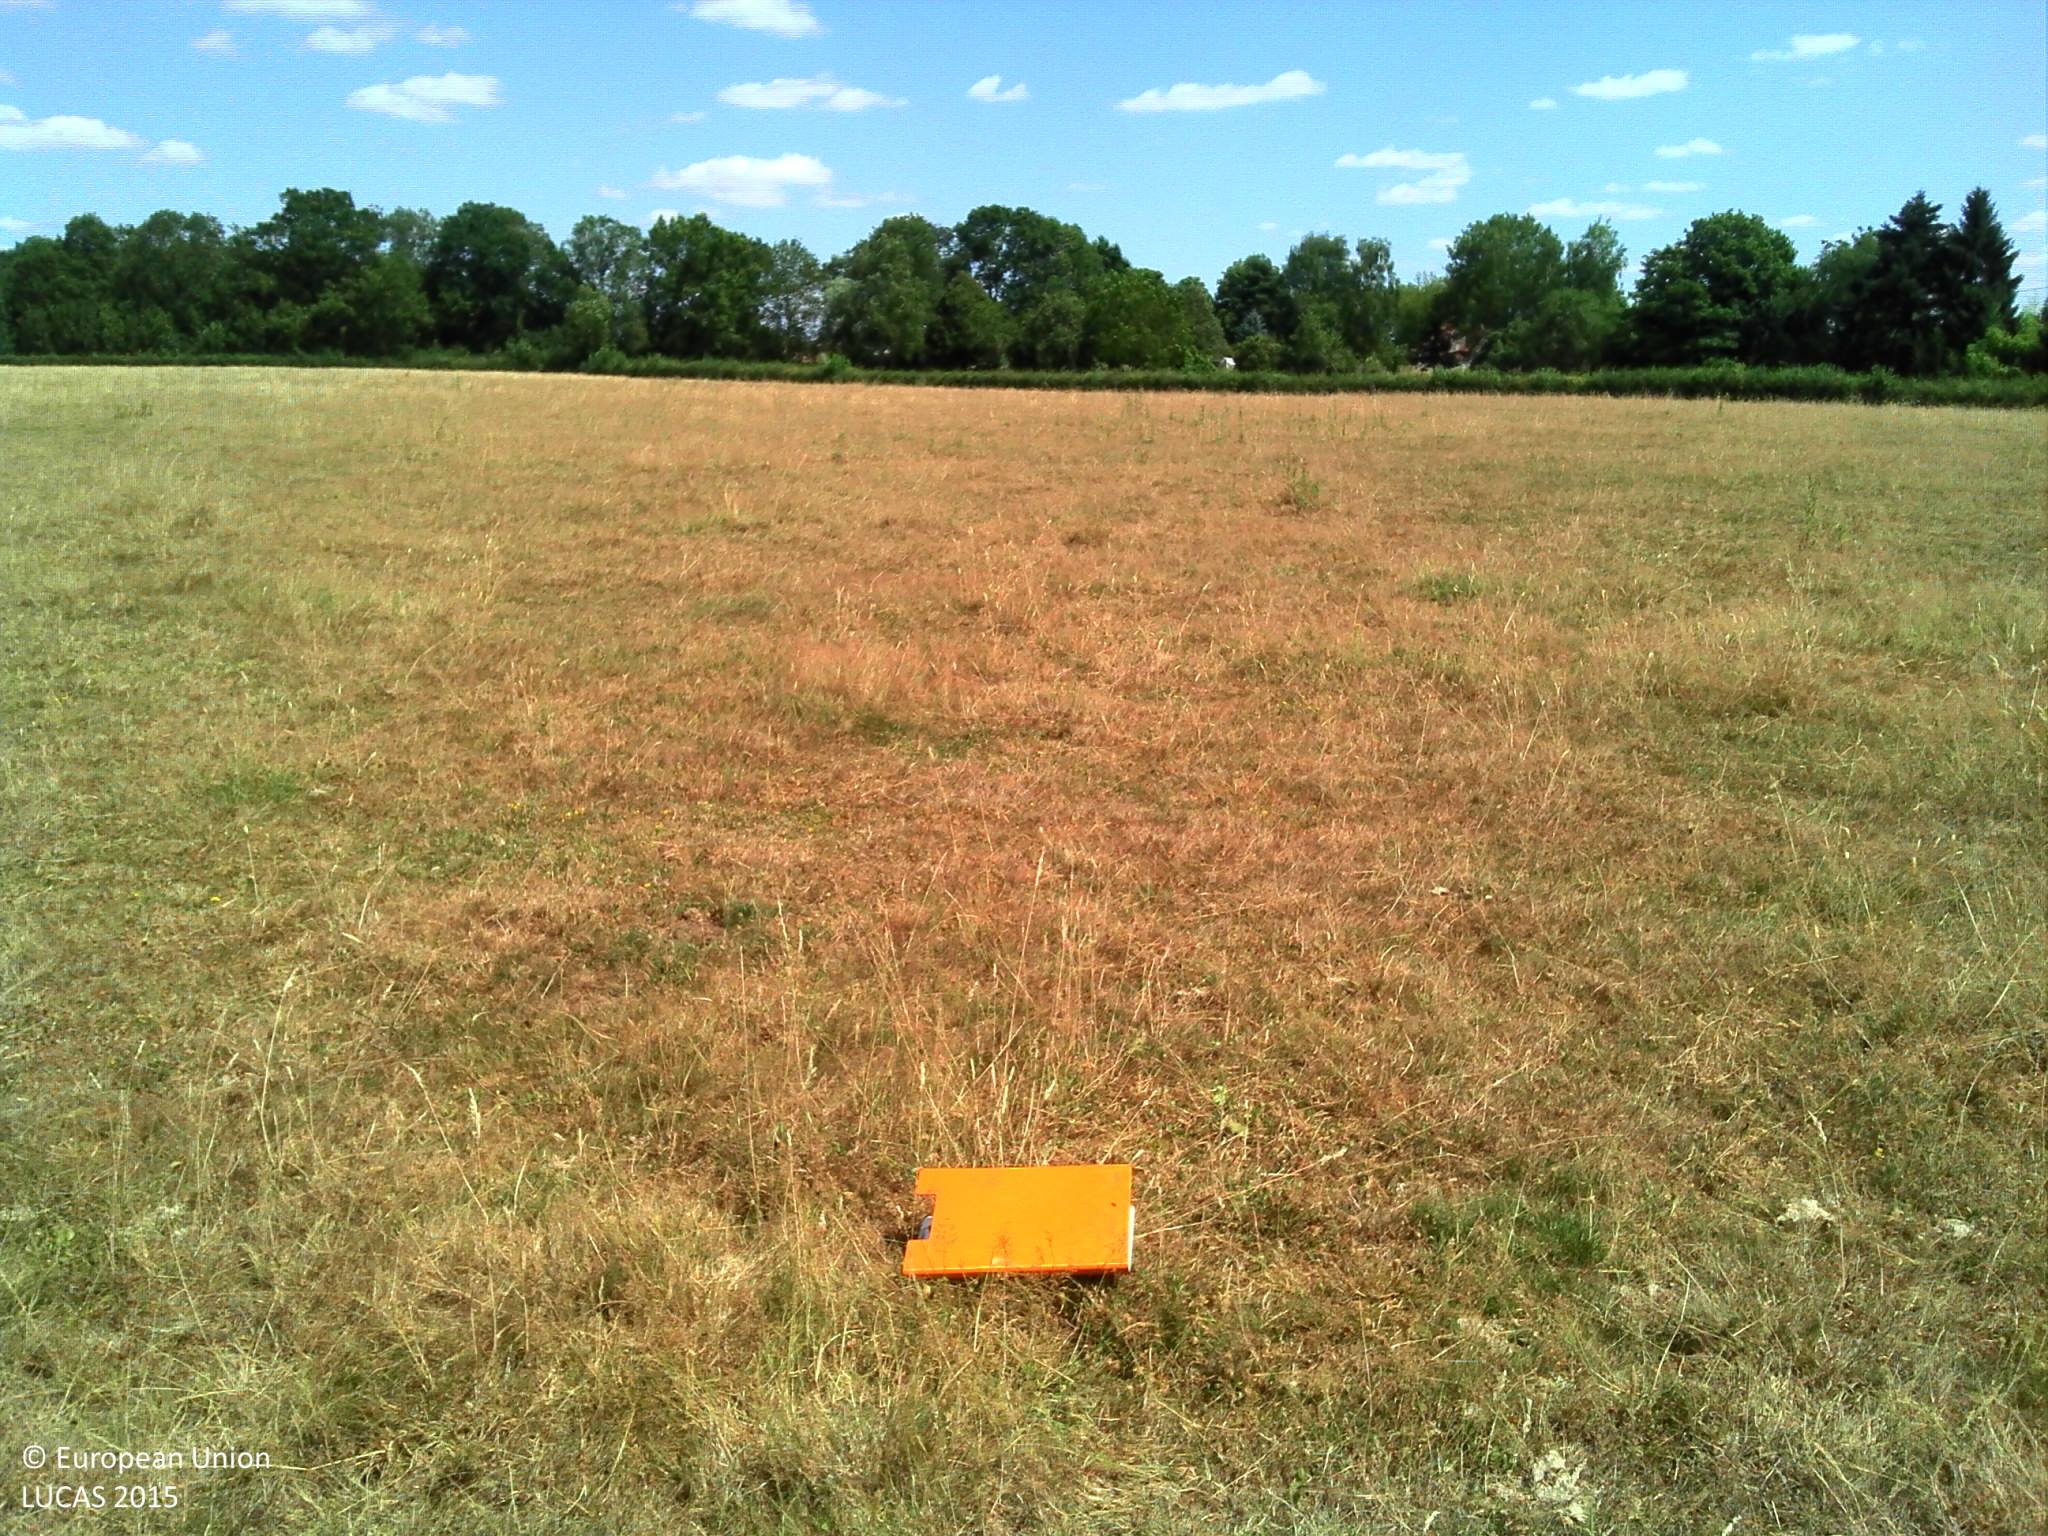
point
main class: Grassland
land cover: Grassland without tree/shrub cover
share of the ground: > 75 %
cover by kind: herbaceous plants 100 %
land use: Agriculture (excluding fallow land and kitchen gardens)
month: July
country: FR
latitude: 46.8482
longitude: 3.6380
